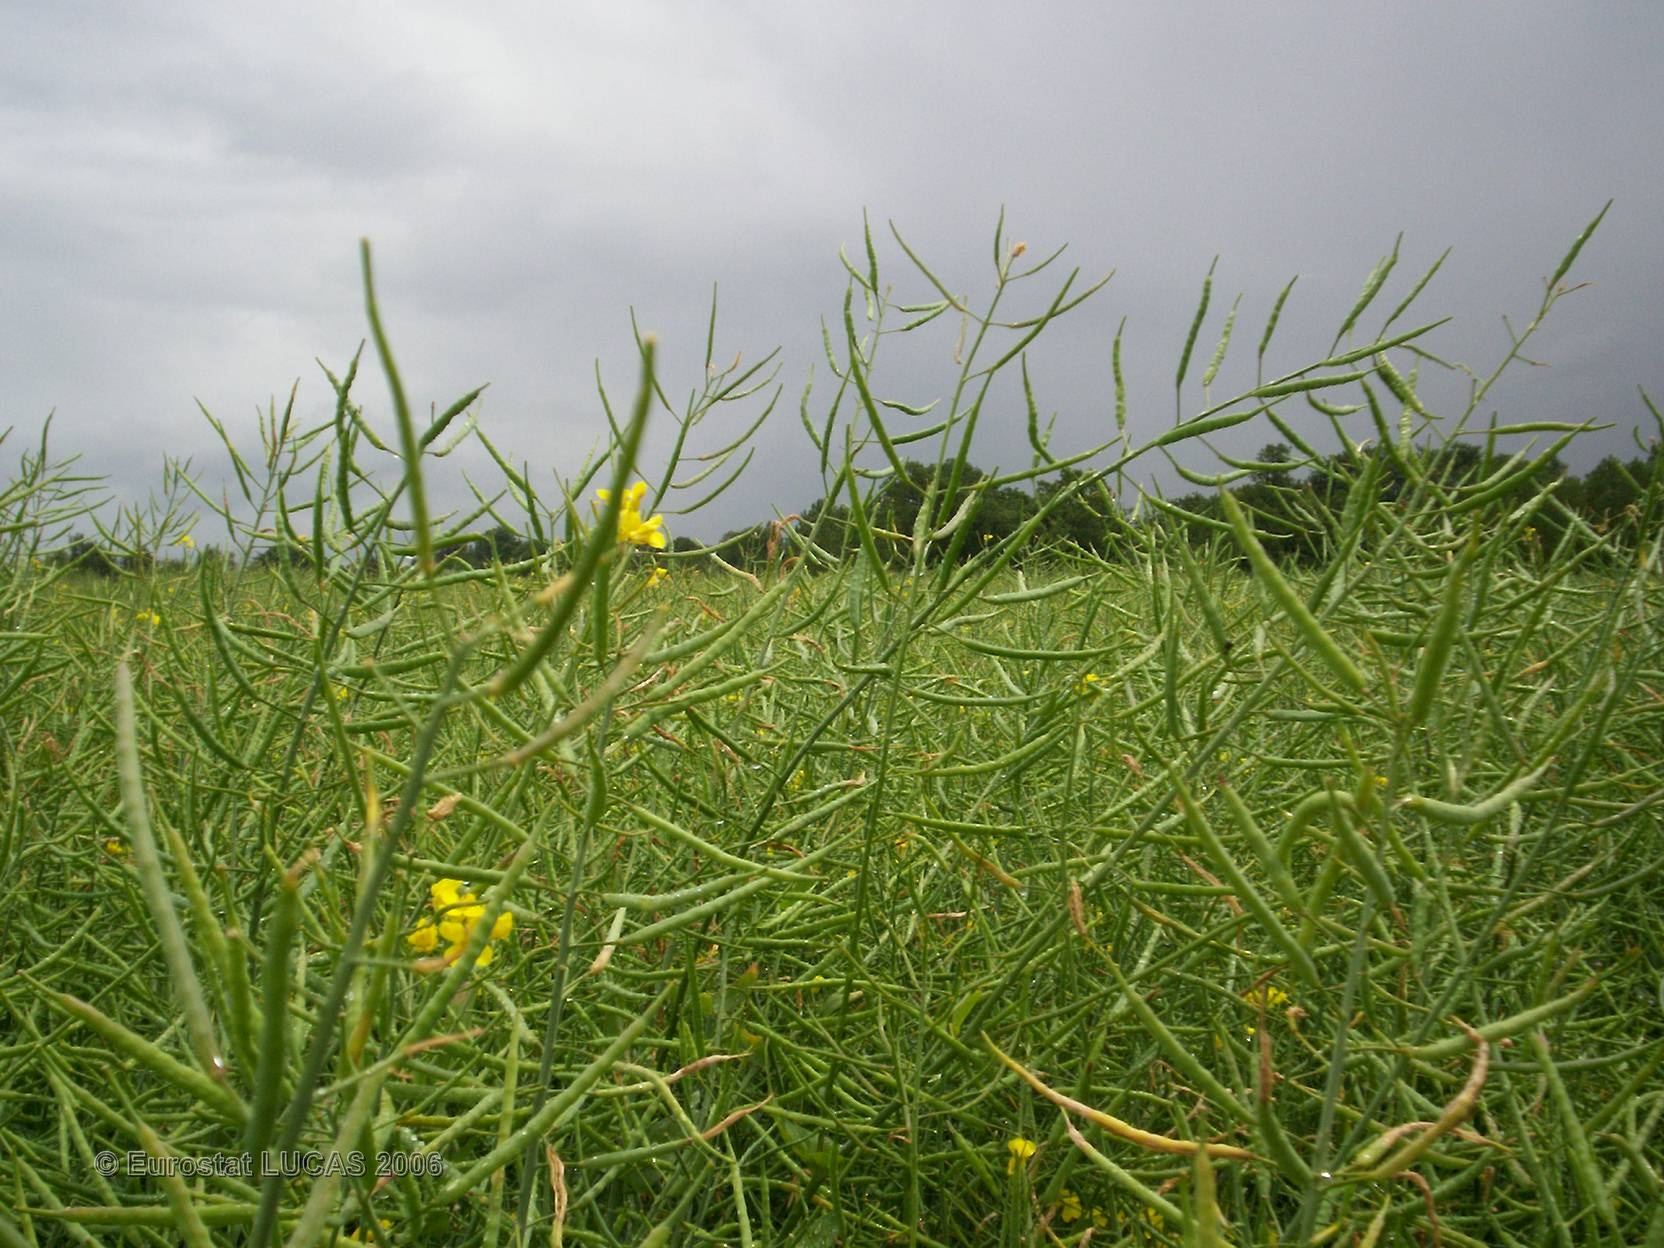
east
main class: Cropland
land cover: Rape and turnip rape
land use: Agriculture (excluding fallow land and kitchen gardens)
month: May
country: FR
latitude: 48.8948
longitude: 2.8568
